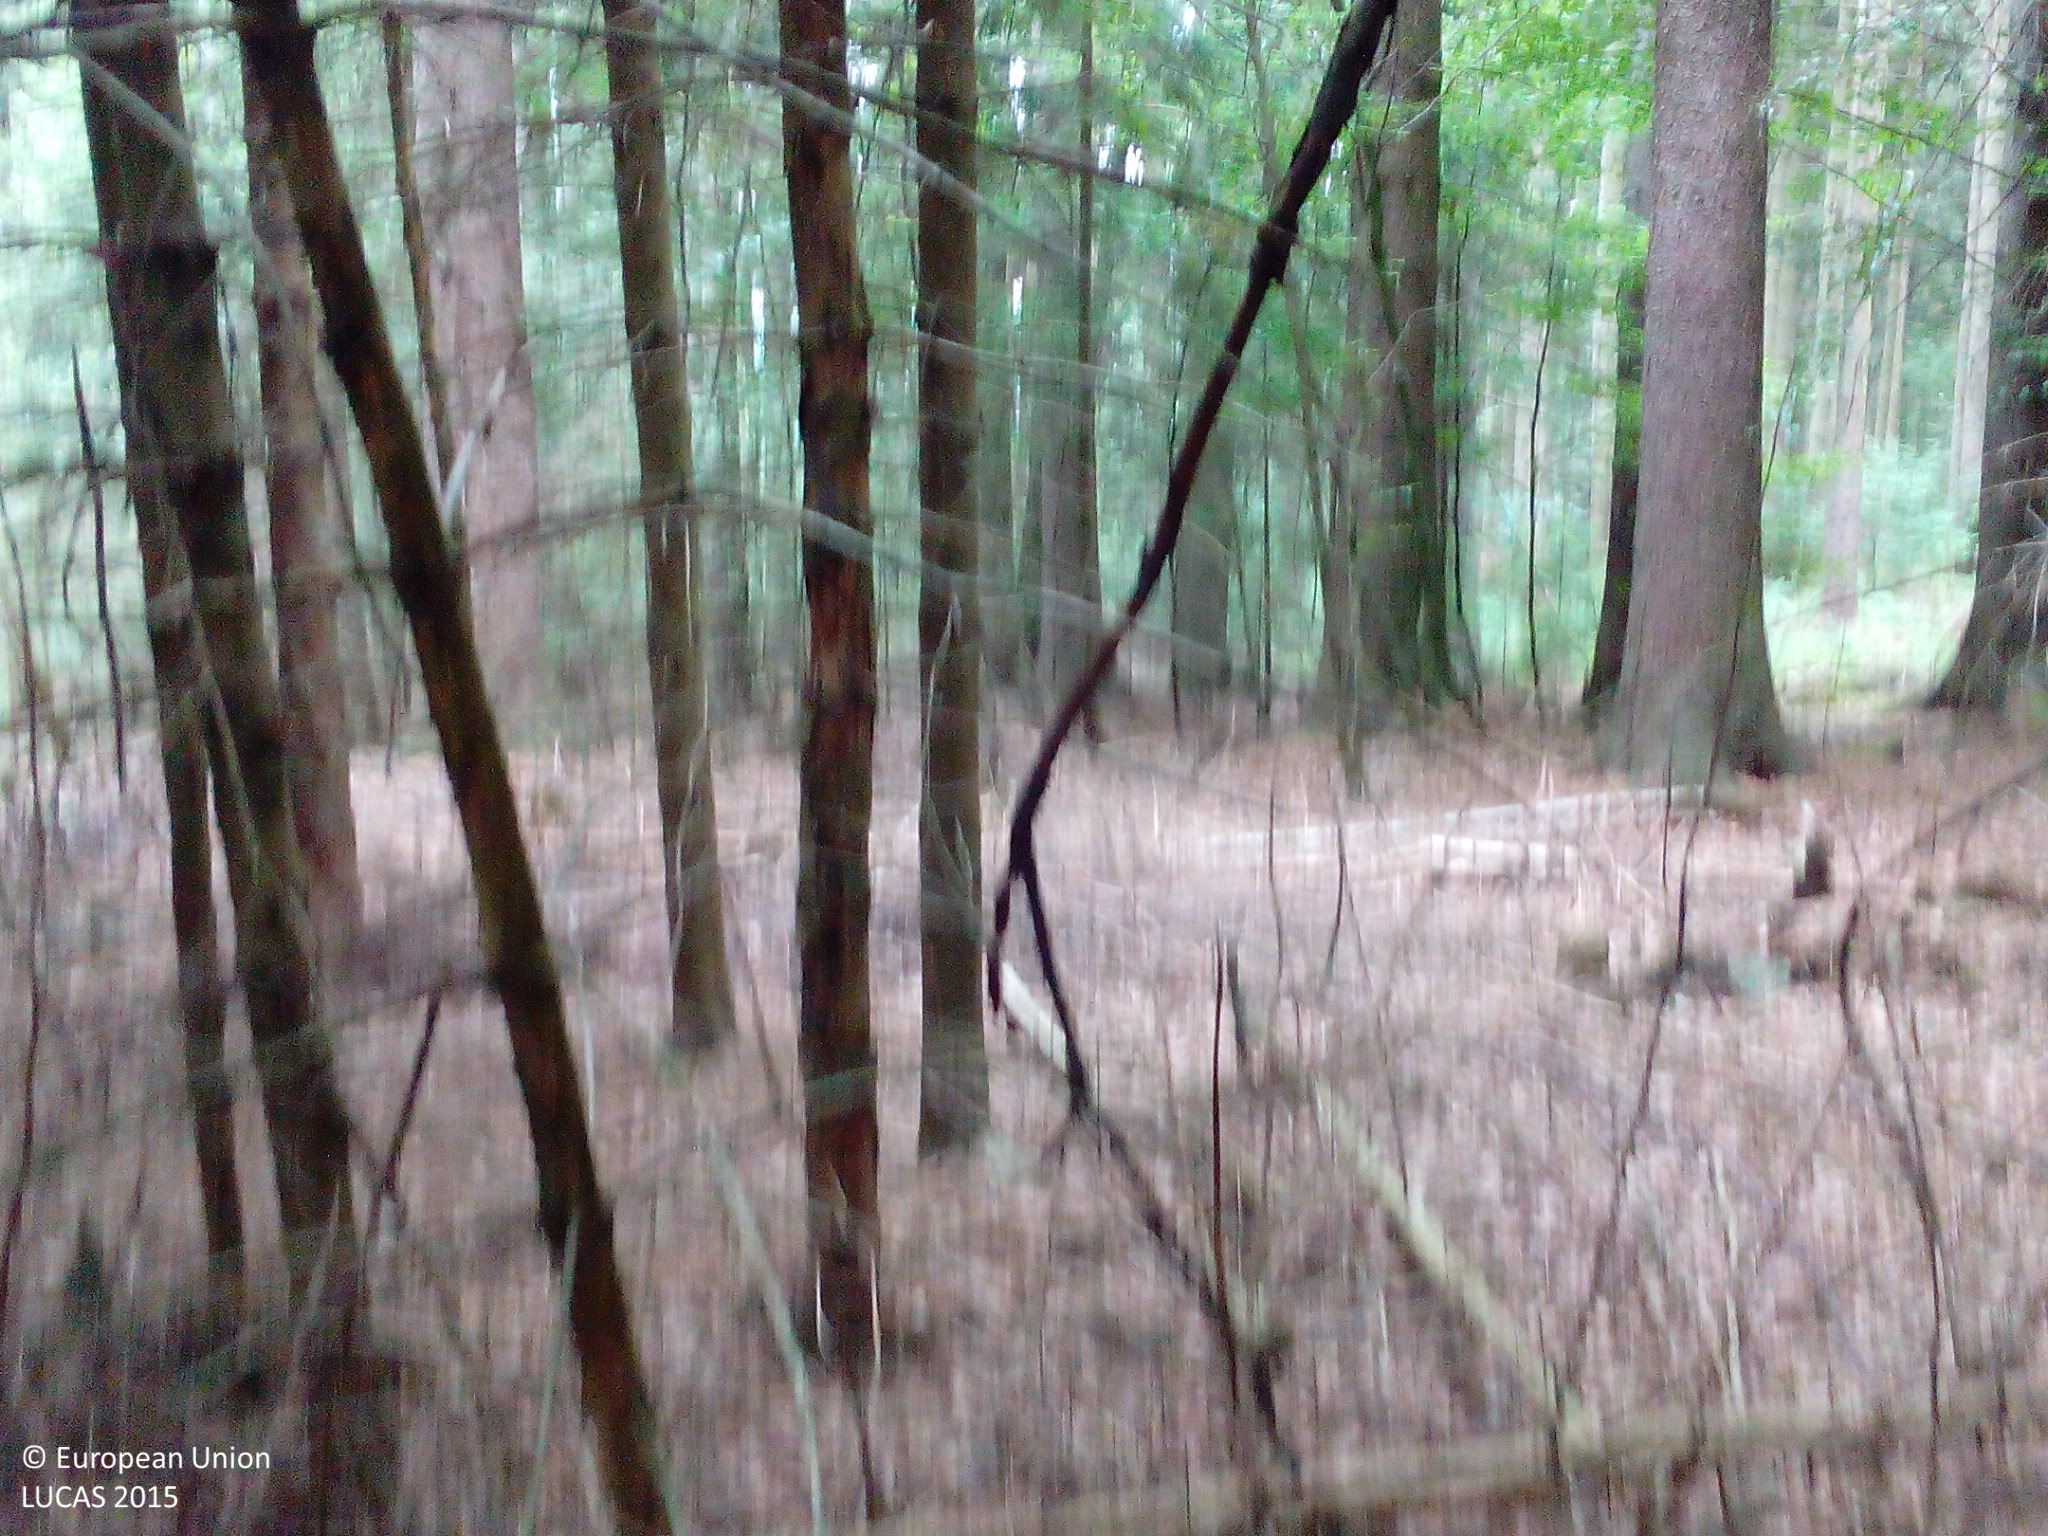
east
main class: Woodland
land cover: Spruce dominated mixed woodland
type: hemiboreal forest and nemoral coniferous forest and mixed broadleaved-coniferous forest
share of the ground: > 75 %
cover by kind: coniferous forest trees 70 %, broadleaved forest trees 30 %
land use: Forestry
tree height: > 5 m
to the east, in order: Spruce dominated mixed woodland; Tracks; Spruce dominated mixed woodland; Spruce dominated coniferous woodland; Tracks; Grassland without tree/shrub cover
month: July
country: DE
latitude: 50.5438
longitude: 9.9295
